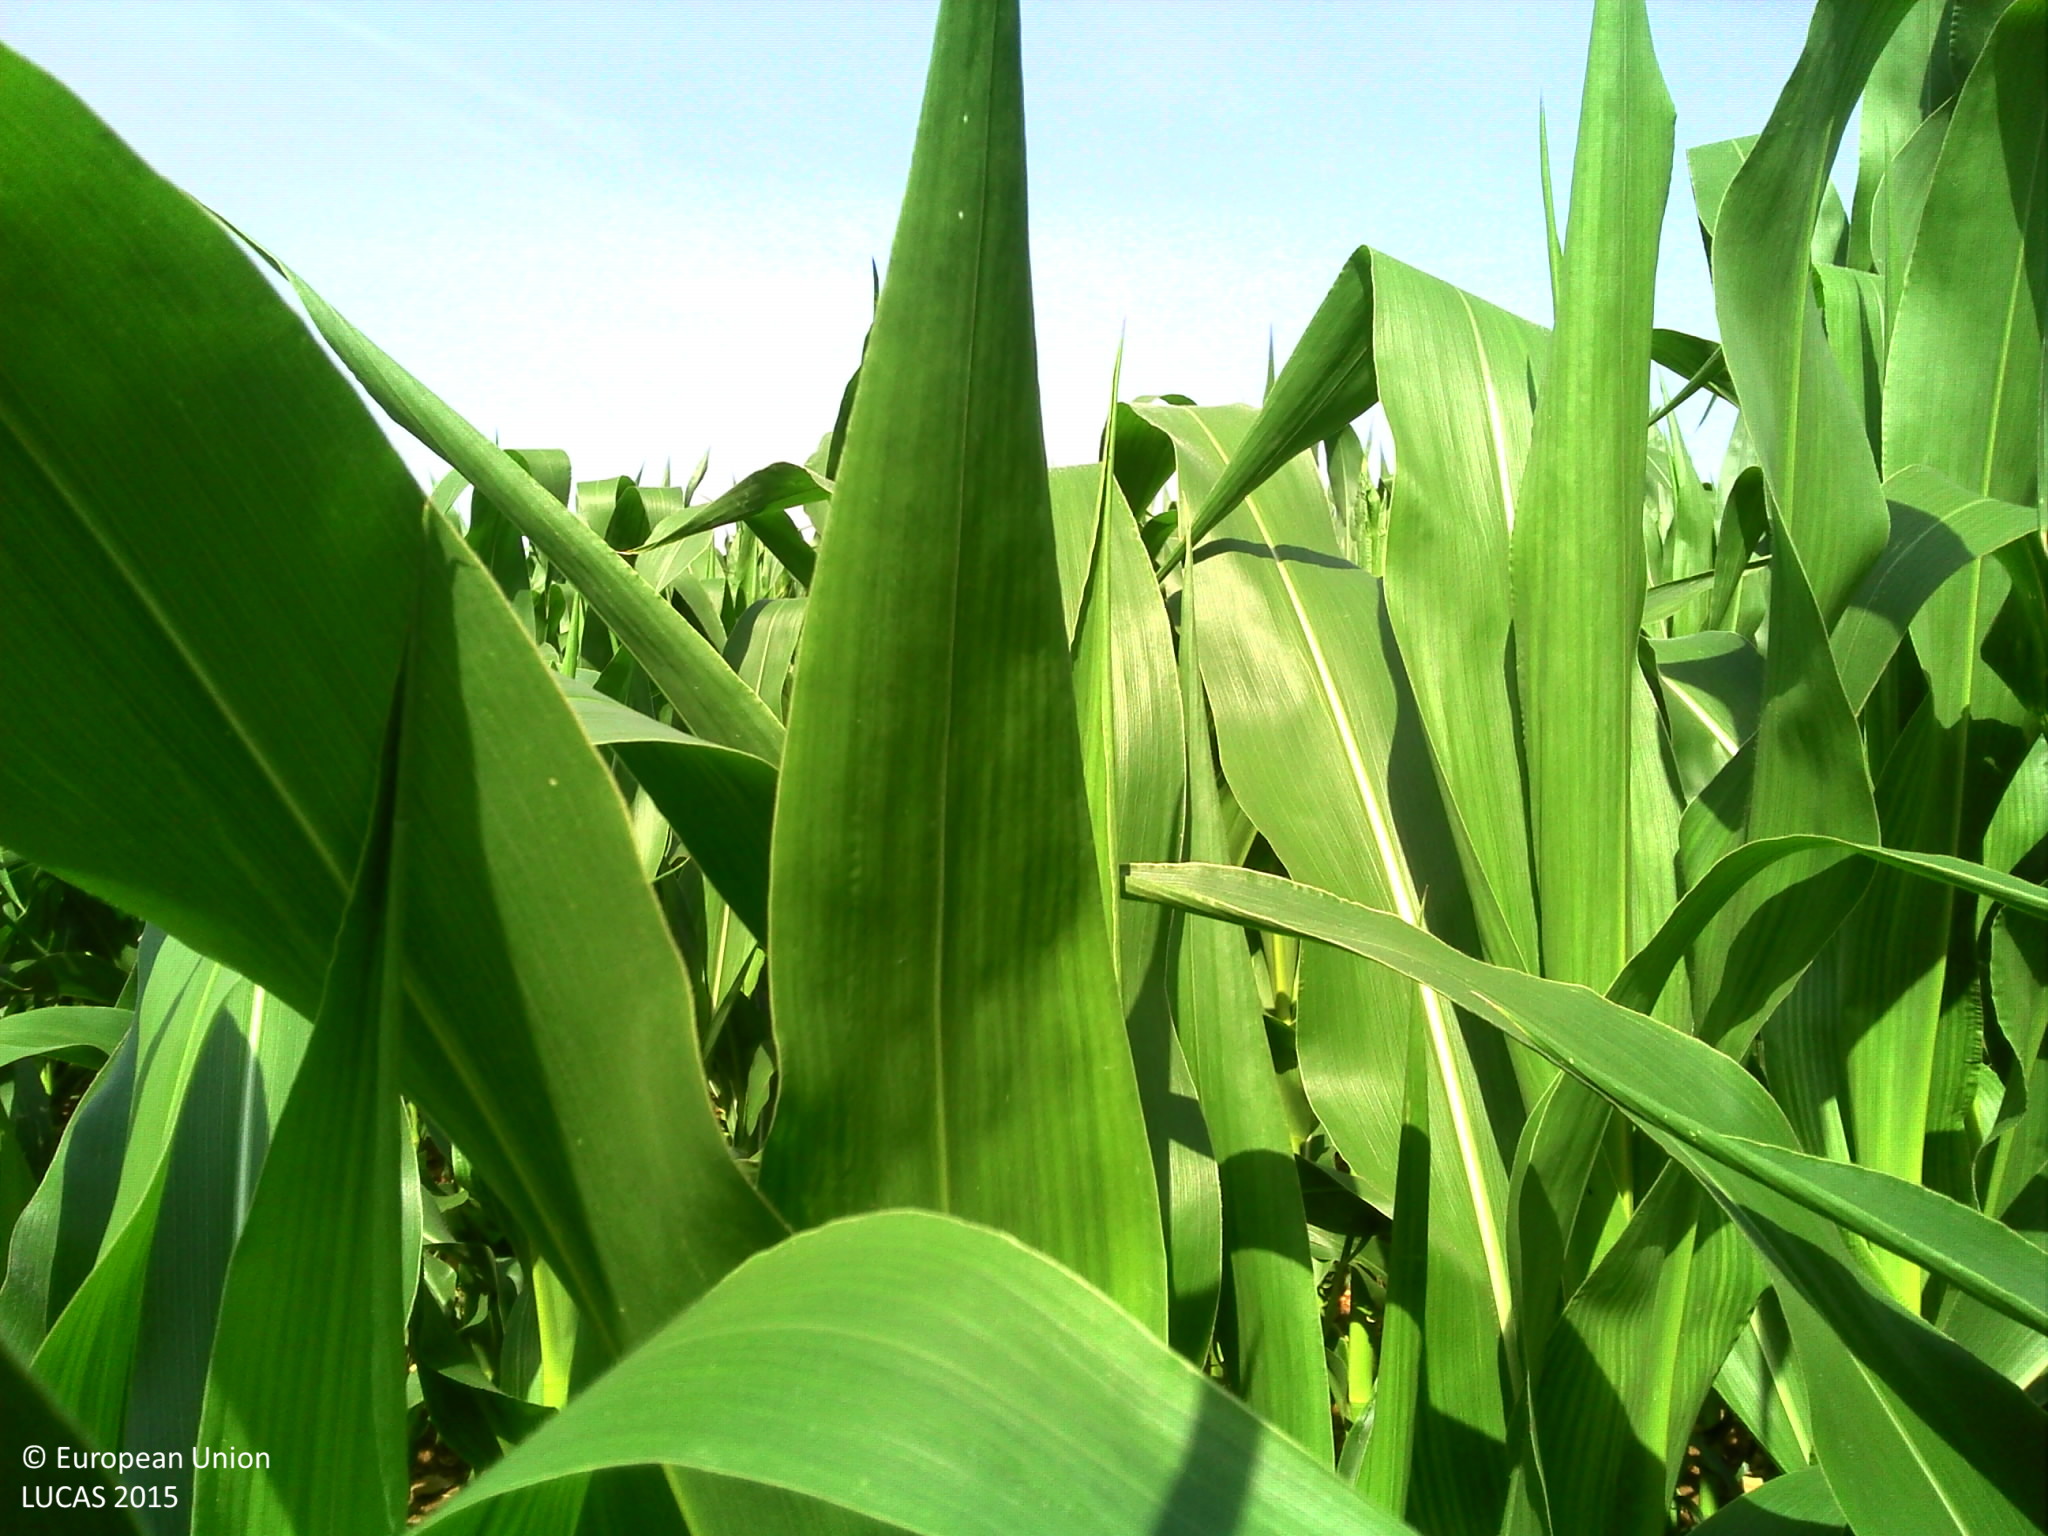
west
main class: Cropland
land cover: Maize
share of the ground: > 75 %
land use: Agriculture (excluding fallow land and kitchen gardens)
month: July
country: FR
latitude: 45.7815
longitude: 5.3608
